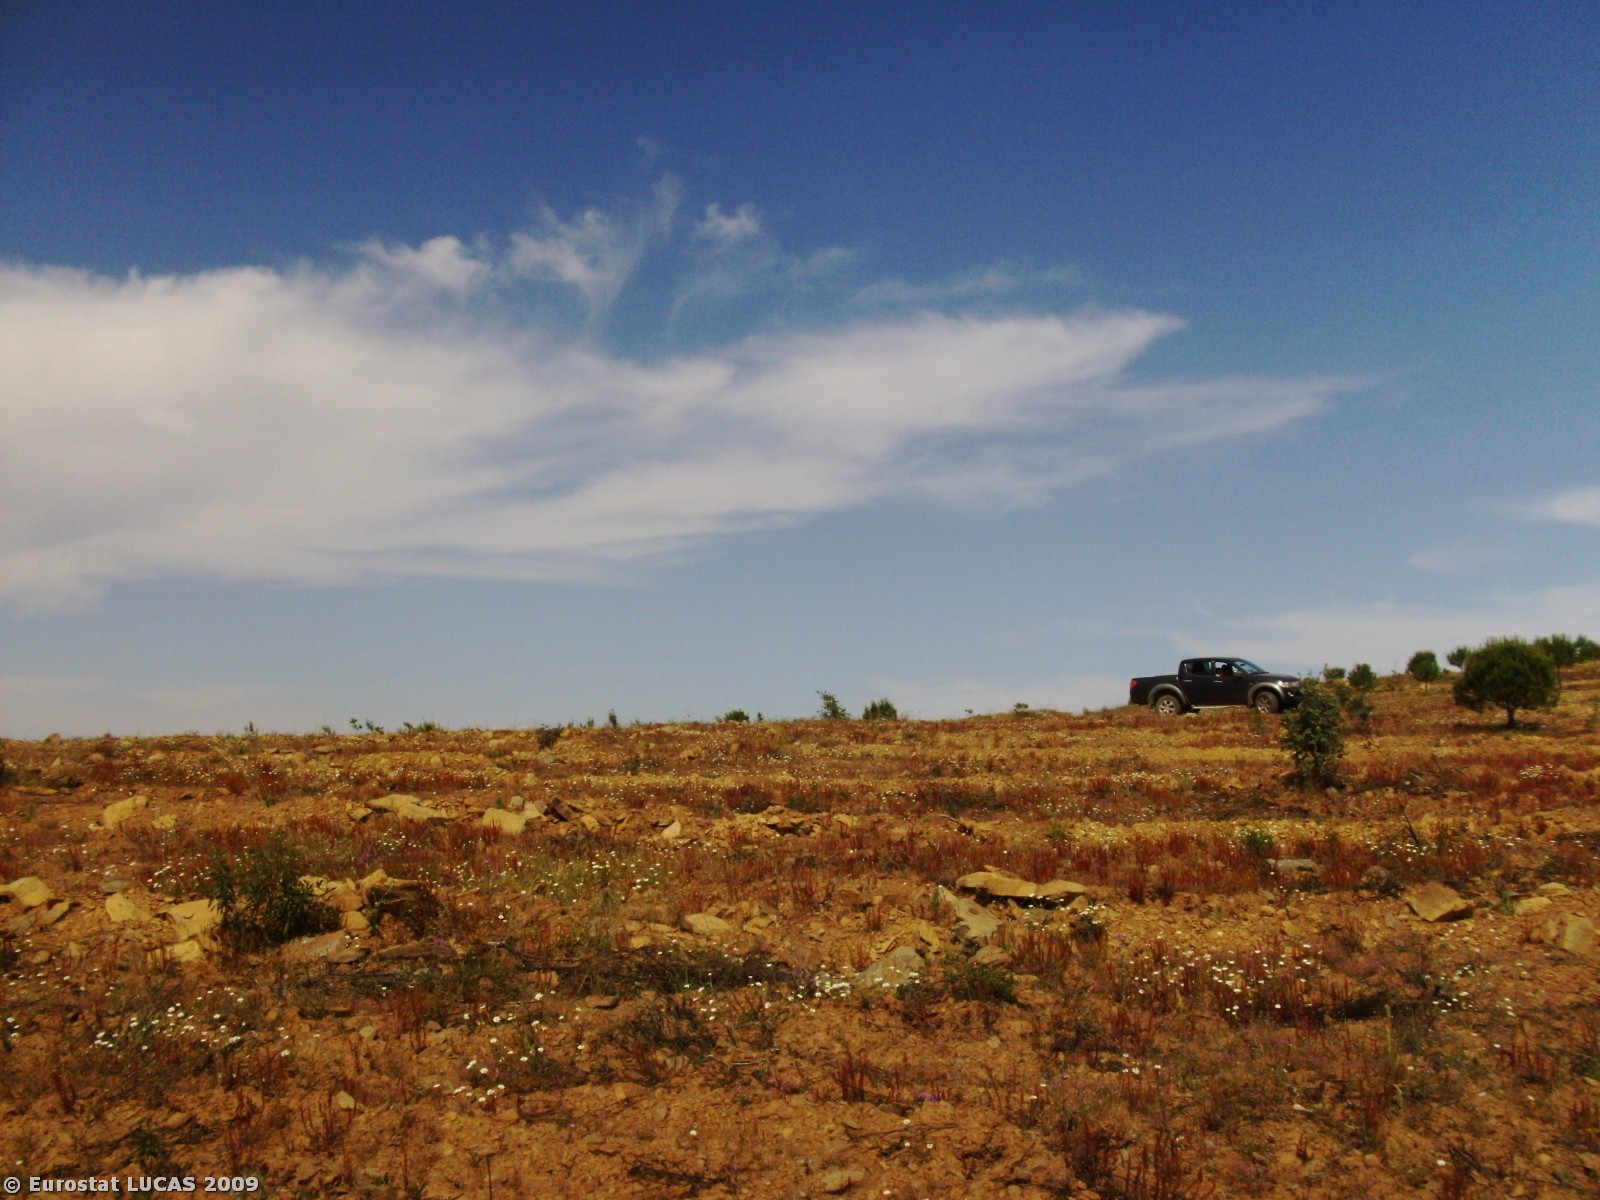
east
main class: Woodland
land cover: Coniferous woodland
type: coniferous forest of the mediterranean region
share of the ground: 10 - 25 %
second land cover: Bare land
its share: > 75 %
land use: Forestry
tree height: > 5 m
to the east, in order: Coniferous woodland; Bare land; Coniferous woodland; Tracks; Coniferous woodland
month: May
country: PT
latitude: 37.4543
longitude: -7.6352
